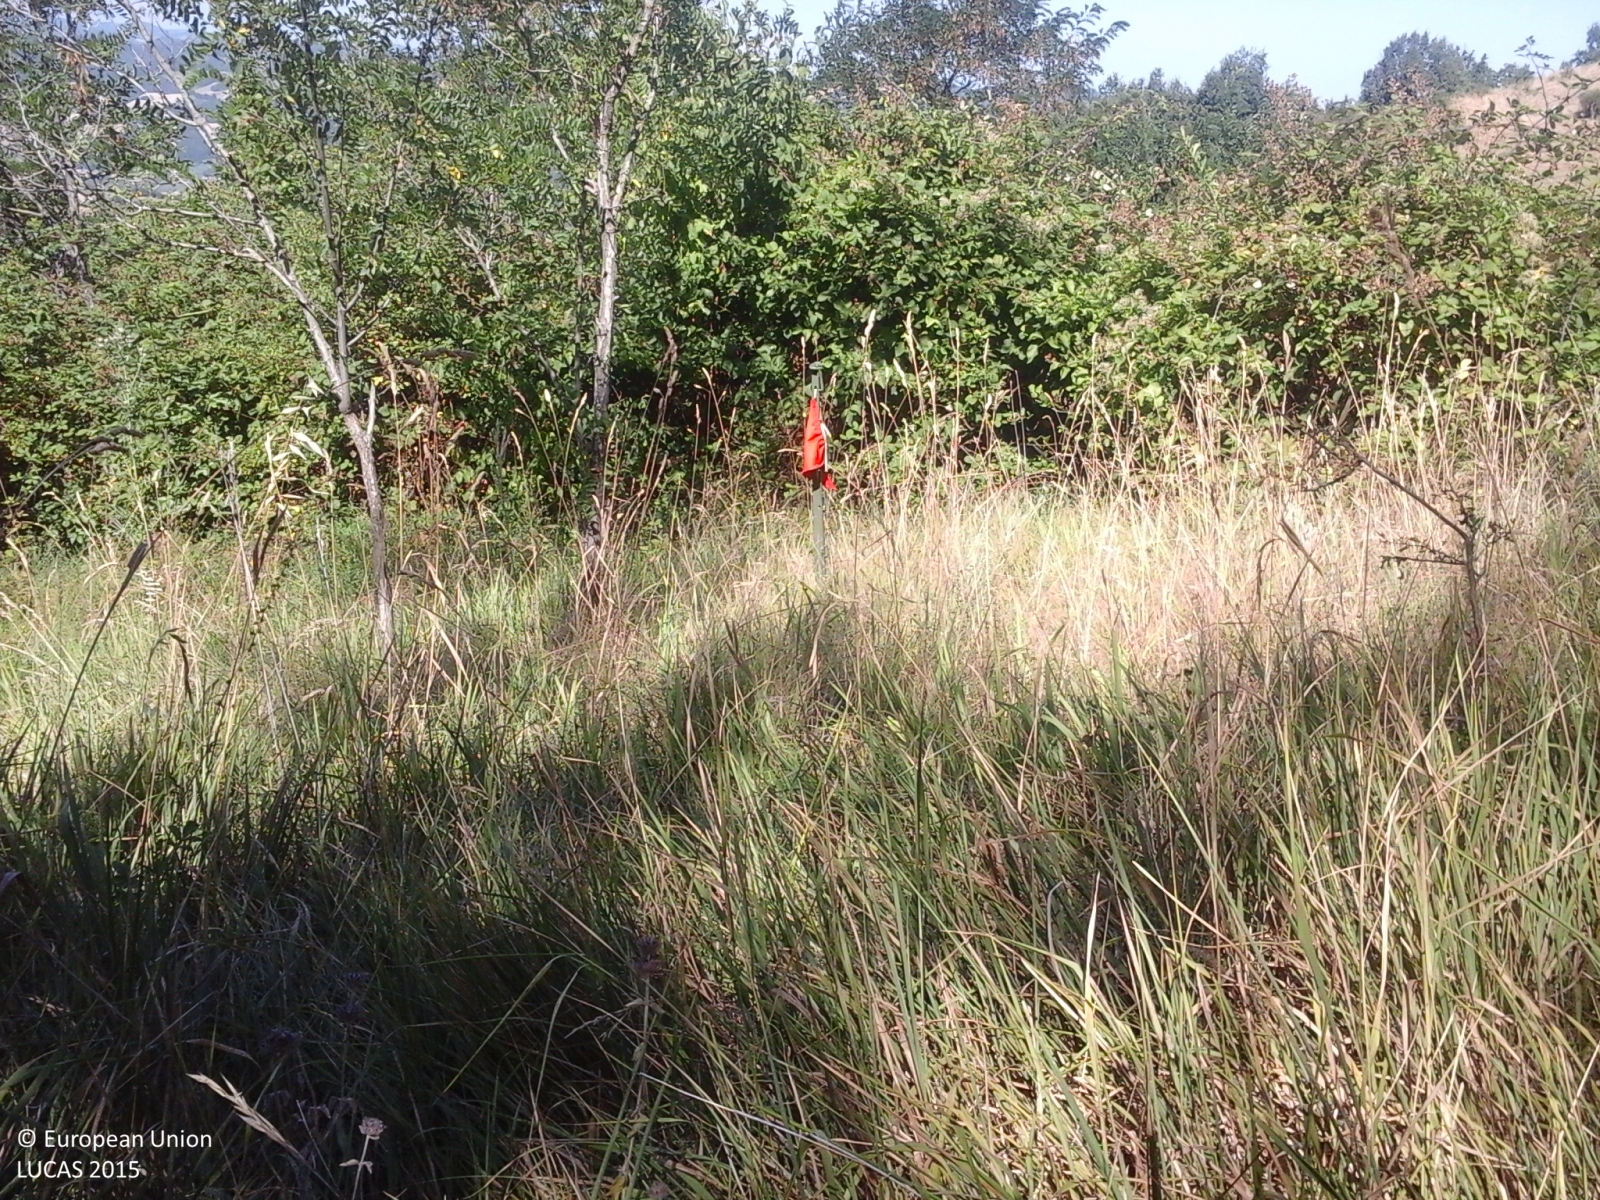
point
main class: Woodland
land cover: Broadleaved woodland
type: thermophilous deciduous forest
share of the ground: > 75 %
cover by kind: broadleaved forest trees 75 %, shrubs 25 %
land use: Forestry
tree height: > 5 m
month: July
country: IT
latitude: 43.9478
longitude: 12.2250
